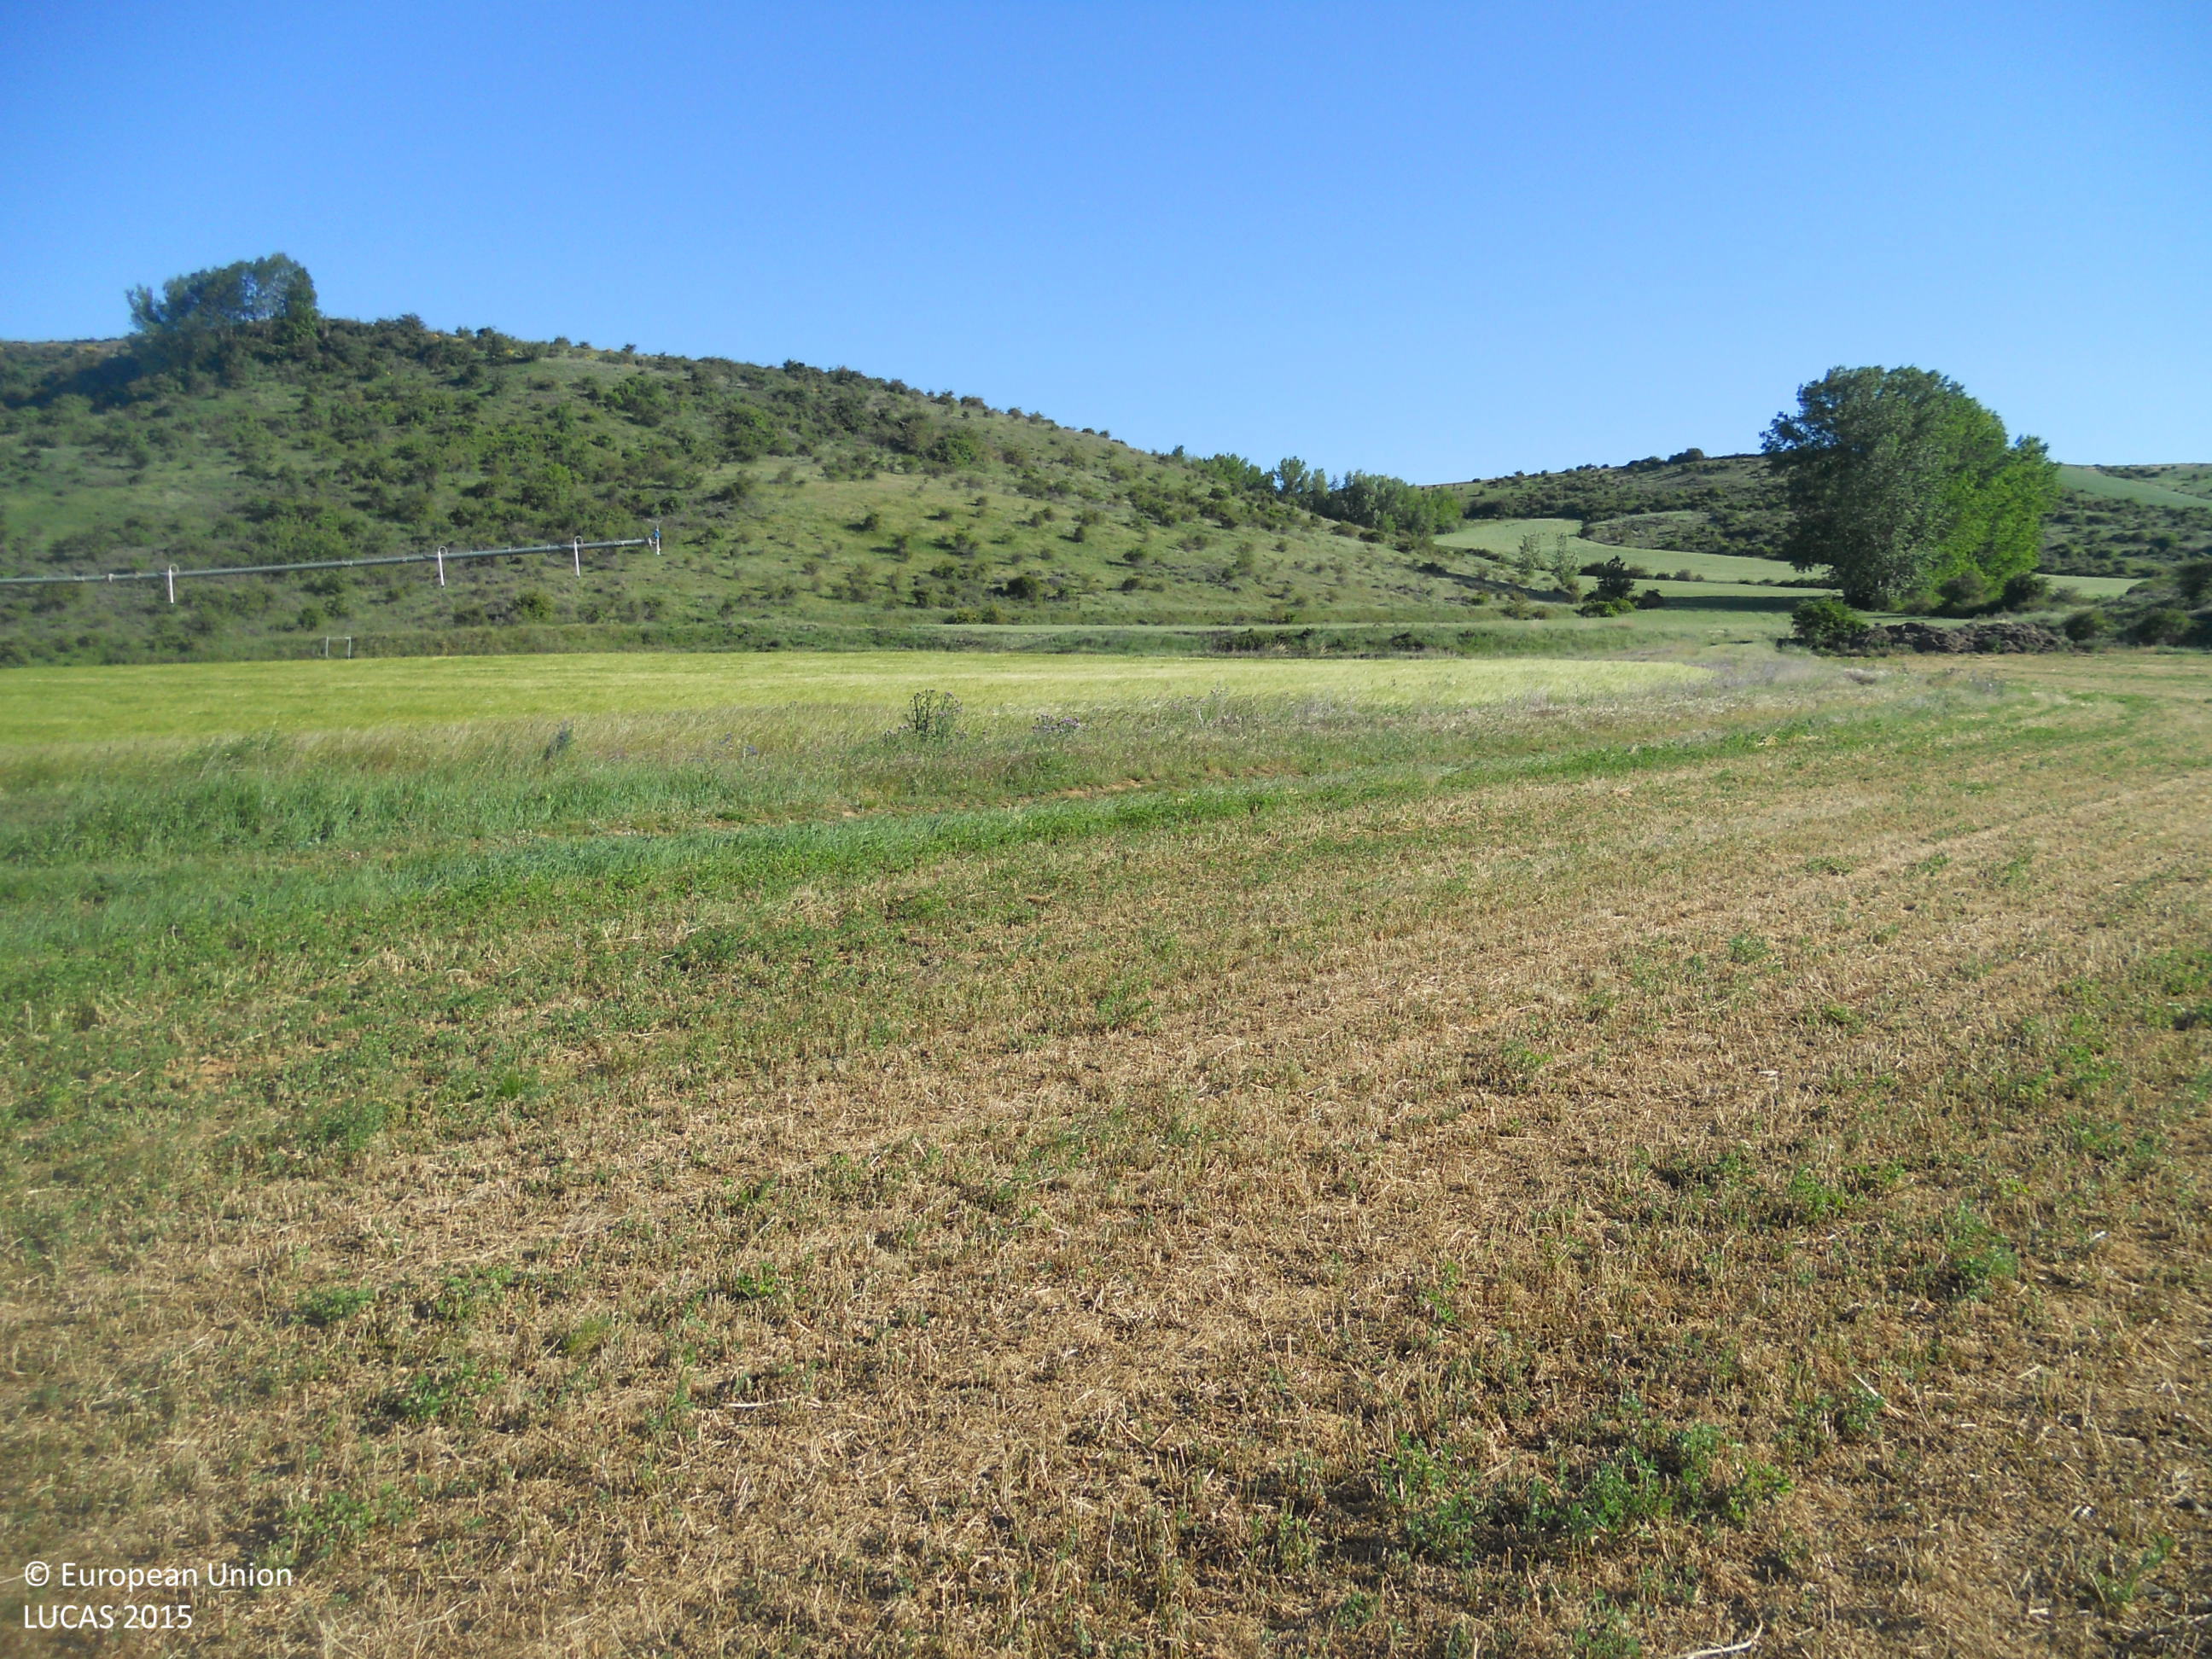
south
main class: Cropland
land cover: Lucerne
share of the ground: > 75 %
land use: Agriculture (excluding fallow land and kitchen gardens)
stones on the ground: < 10 %
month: May
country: ES
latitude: 42.3993
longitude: -4.3220
